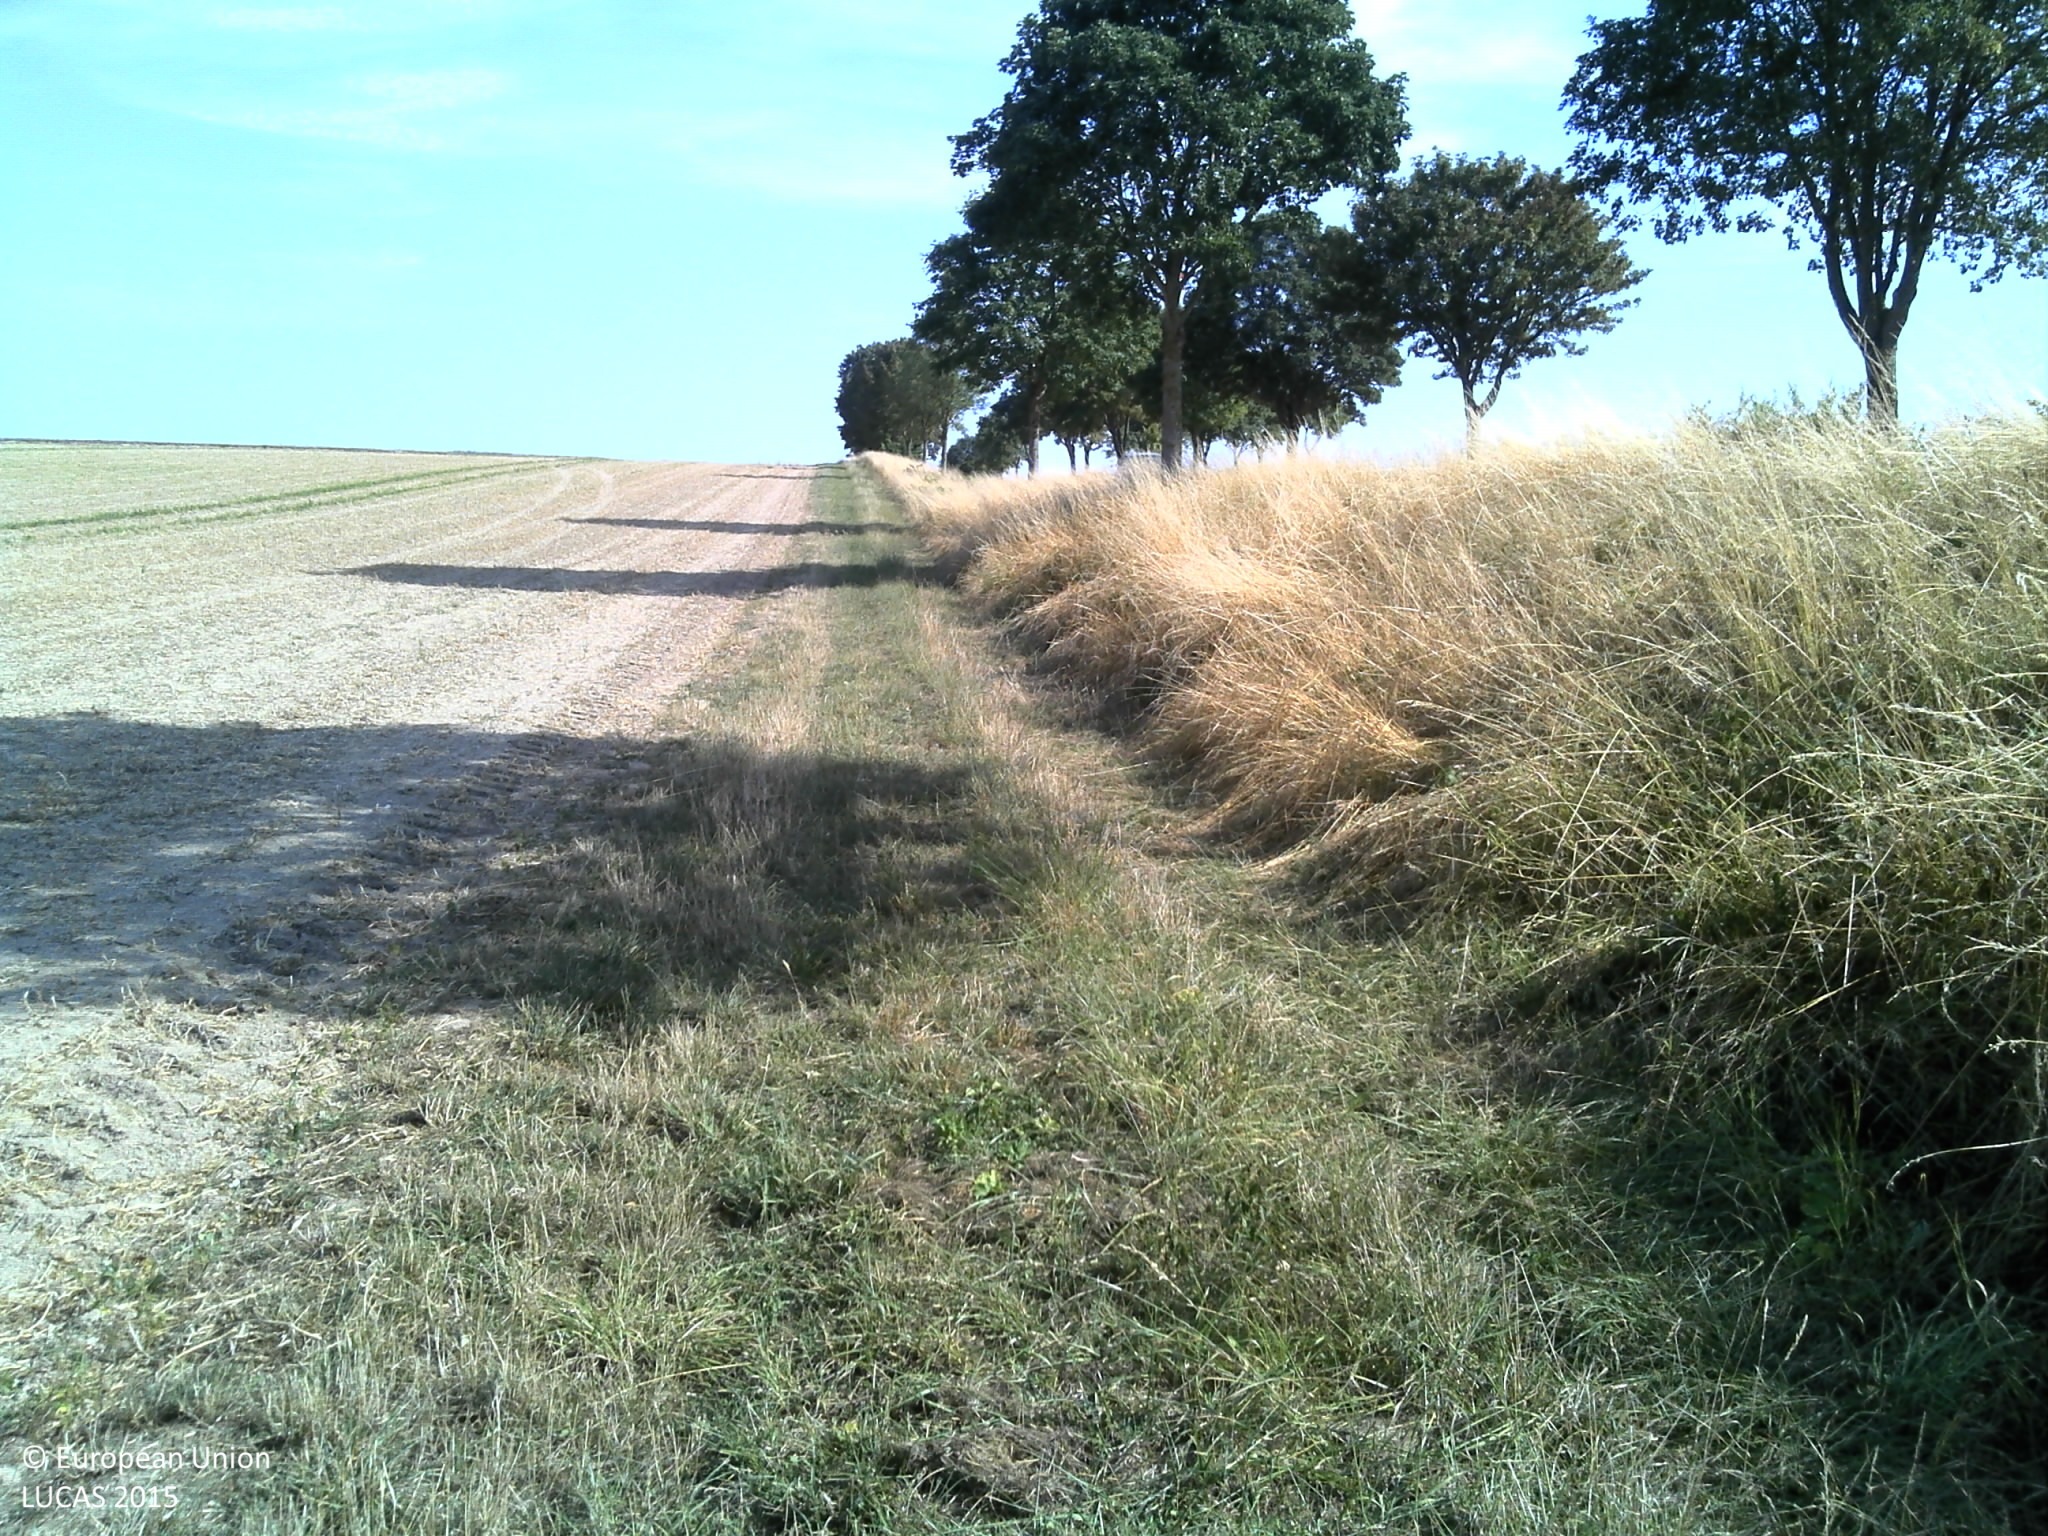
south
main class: Grassland
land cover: Grassland without tree/shrub cover
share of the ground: > 75 %
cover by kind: herbaceous plants 95 %, shrubs 5 %
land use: Road transport
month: August
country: FR
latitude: 49.0902
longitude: 4.7526
